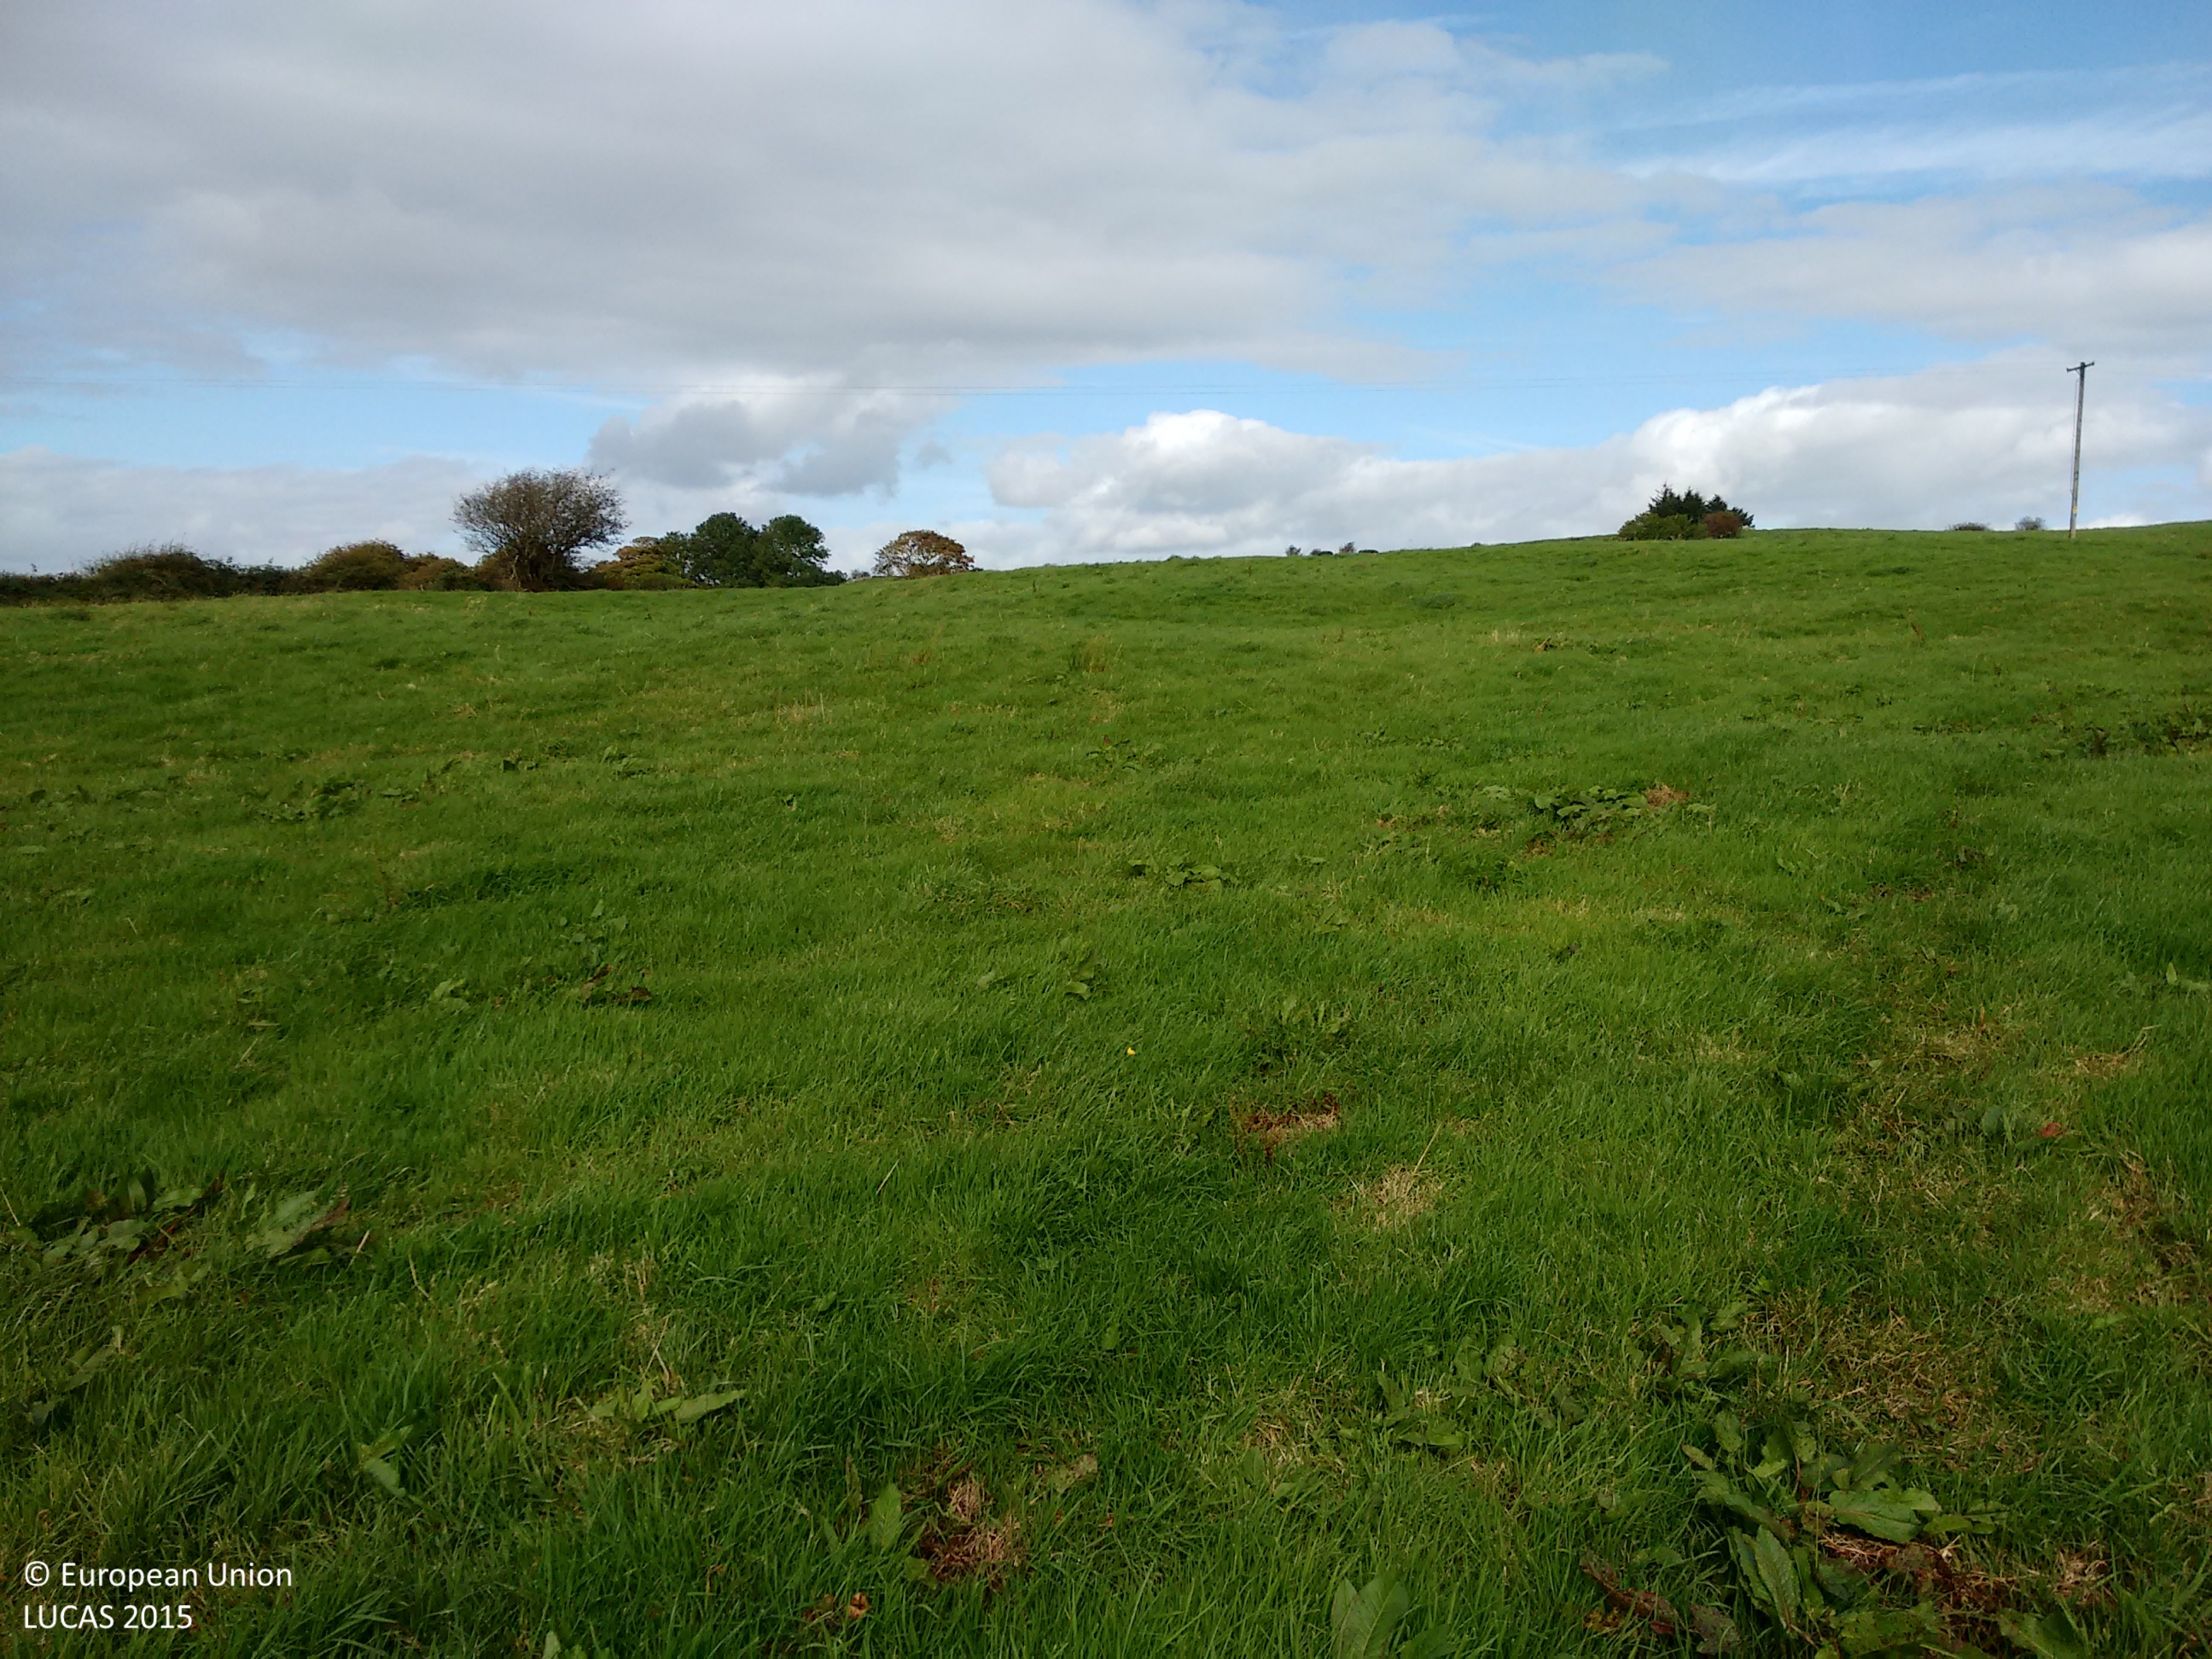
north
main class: Grassland
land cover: Grassland with sparse tree/shrub cover
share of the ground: > 75 %
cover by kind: herbaceous plants 90 %, broadleaved forest trees 5 %, shrubs 5 %
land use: Agriculture (excluding fallow land and kitchen gardens)
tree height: < 5 m
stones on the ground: < 10 %
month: September
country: IE
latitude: 53.8041
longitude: -8.8684
